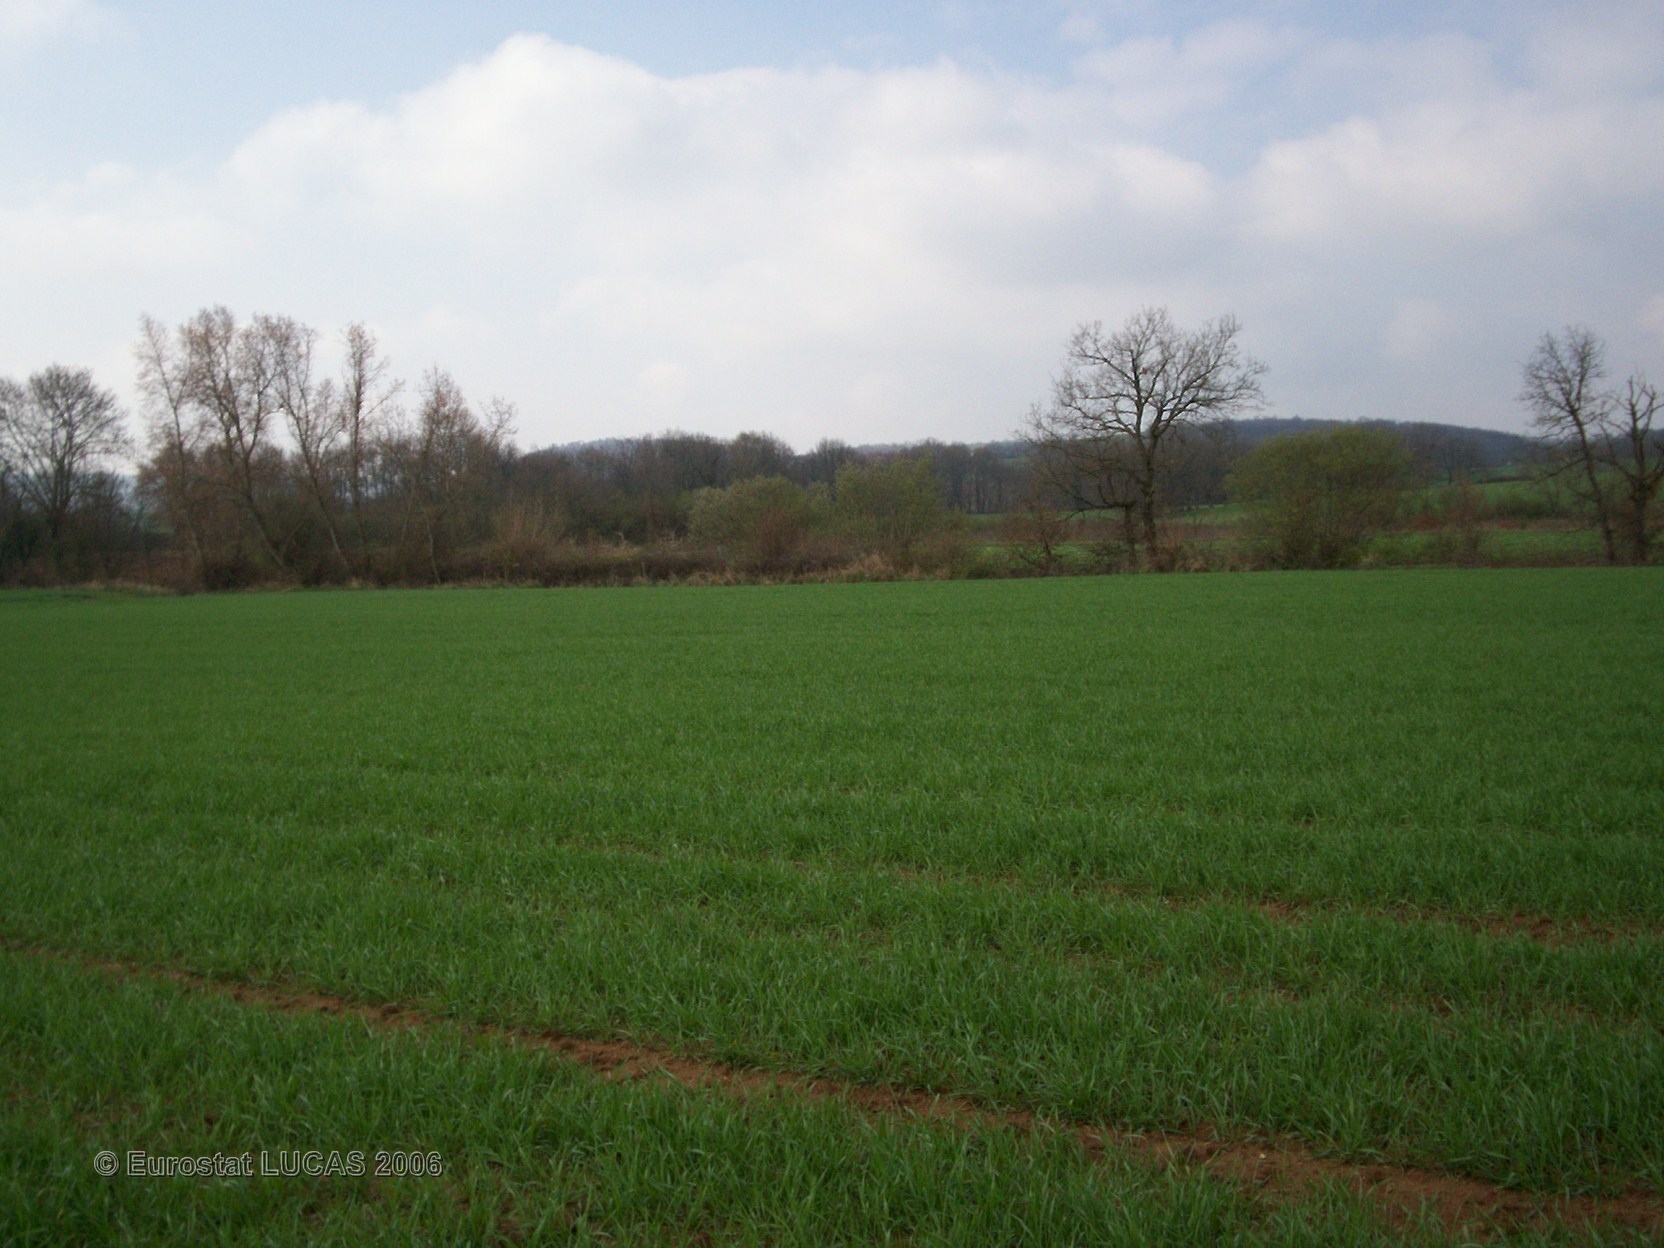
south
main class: Cropland
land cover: Common wheat
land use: Agriculture (excluding fallow land and kitchen gardens)
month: April
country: FR
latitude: 45.3638
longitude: 3.2991
